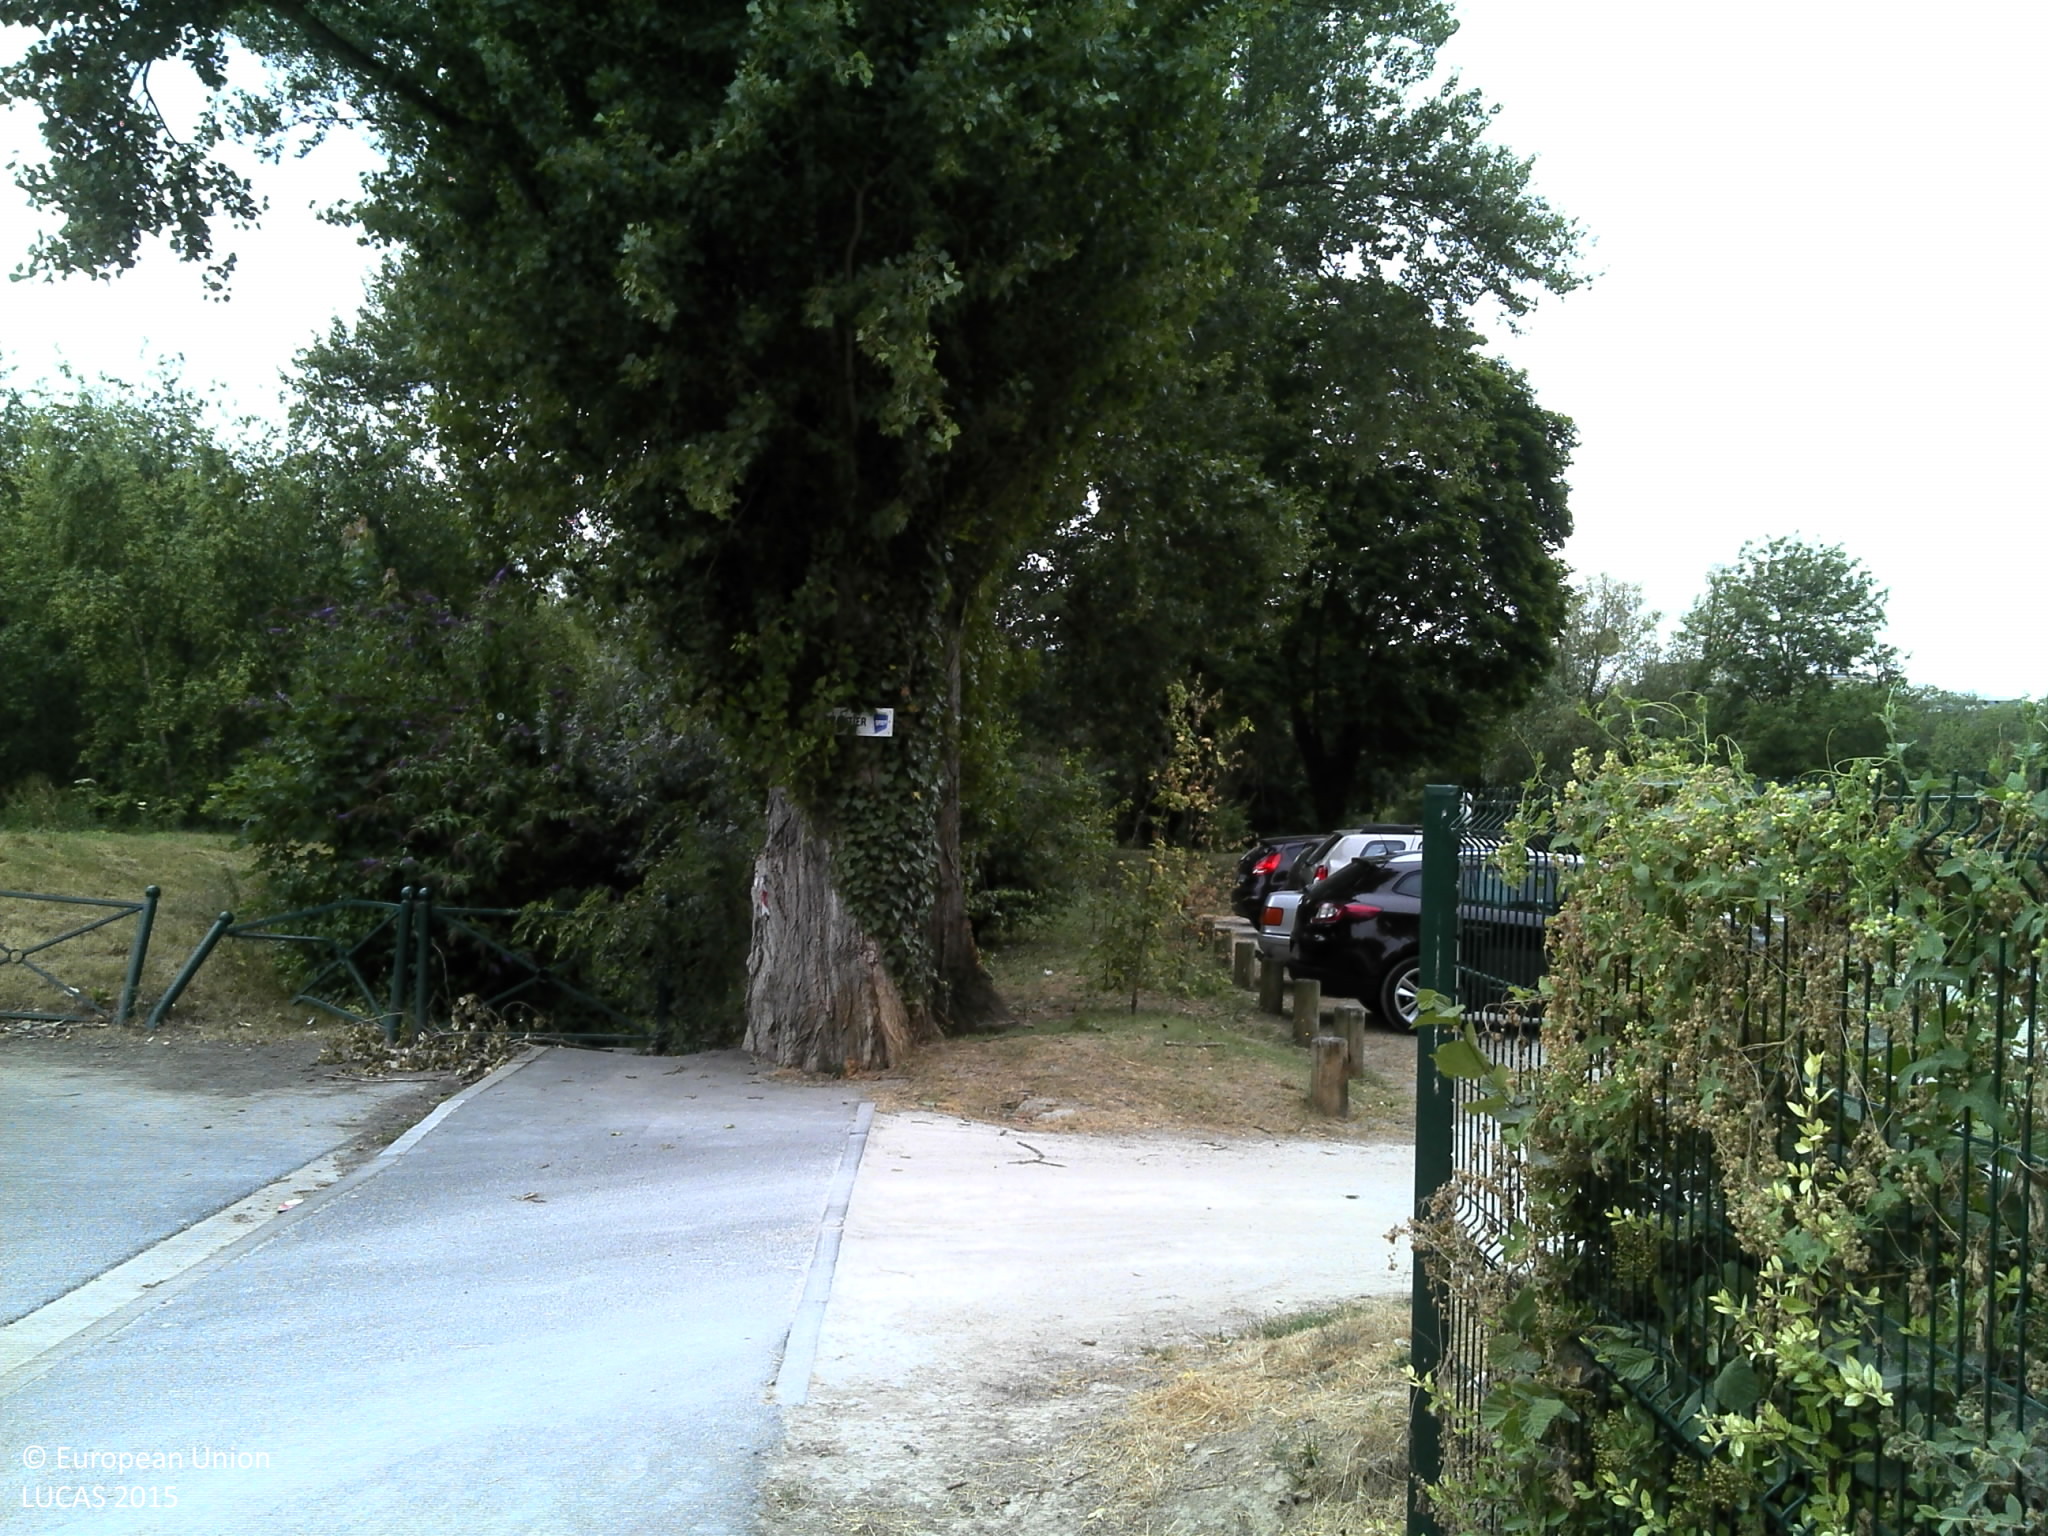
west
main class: Woodland
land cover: Broadleaved woodland
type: floodplain forest
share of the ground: > 75 %
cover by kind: broadleaved forest trees 70 %, herbaceous plants 30 %
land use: Amenities, museums, leisure
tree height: > 5 m
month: July
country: FR
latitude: 48.5996
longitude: 2.4903
